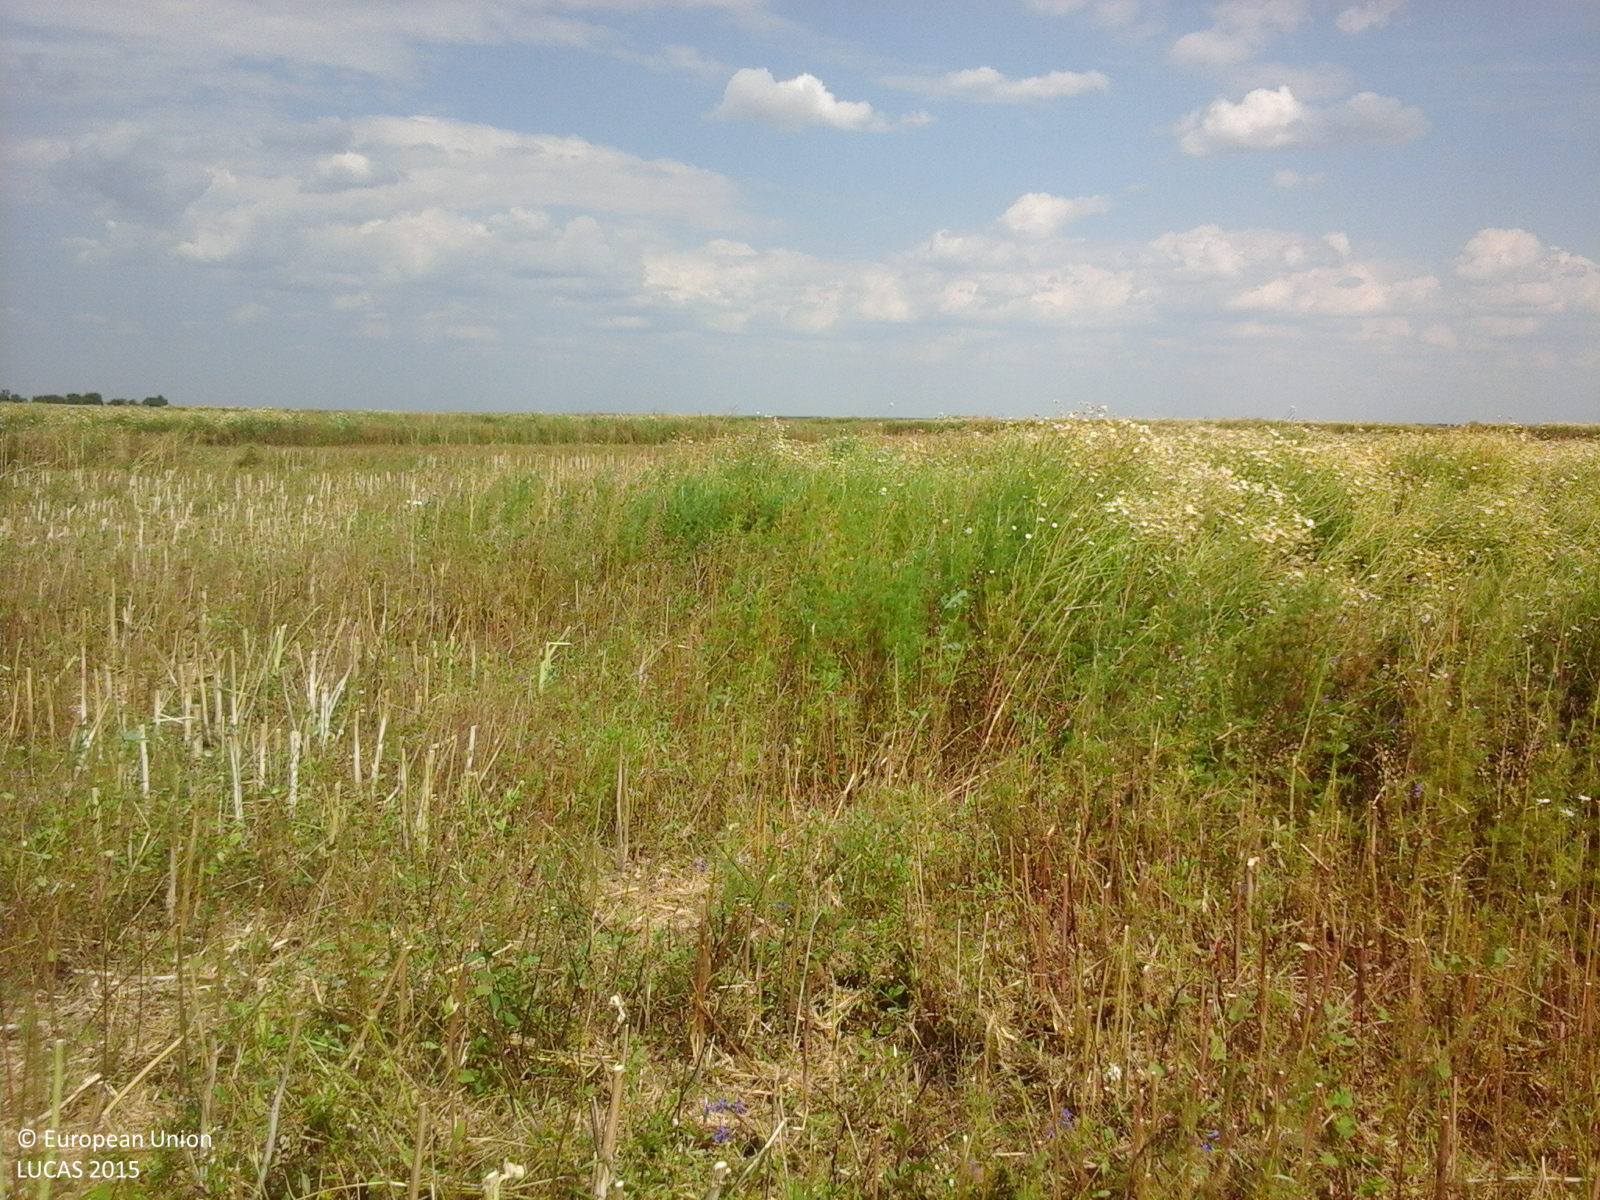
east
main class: Cropland
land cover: Rape and turnip rape
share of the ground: < 10 %
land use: Agriculture (excluding fallow land and kitchen gardens)
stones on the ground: 10 - 25 %
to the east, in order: Rape and turnip rape
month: June
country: RO
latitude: 44.6120
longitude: 26.3043
